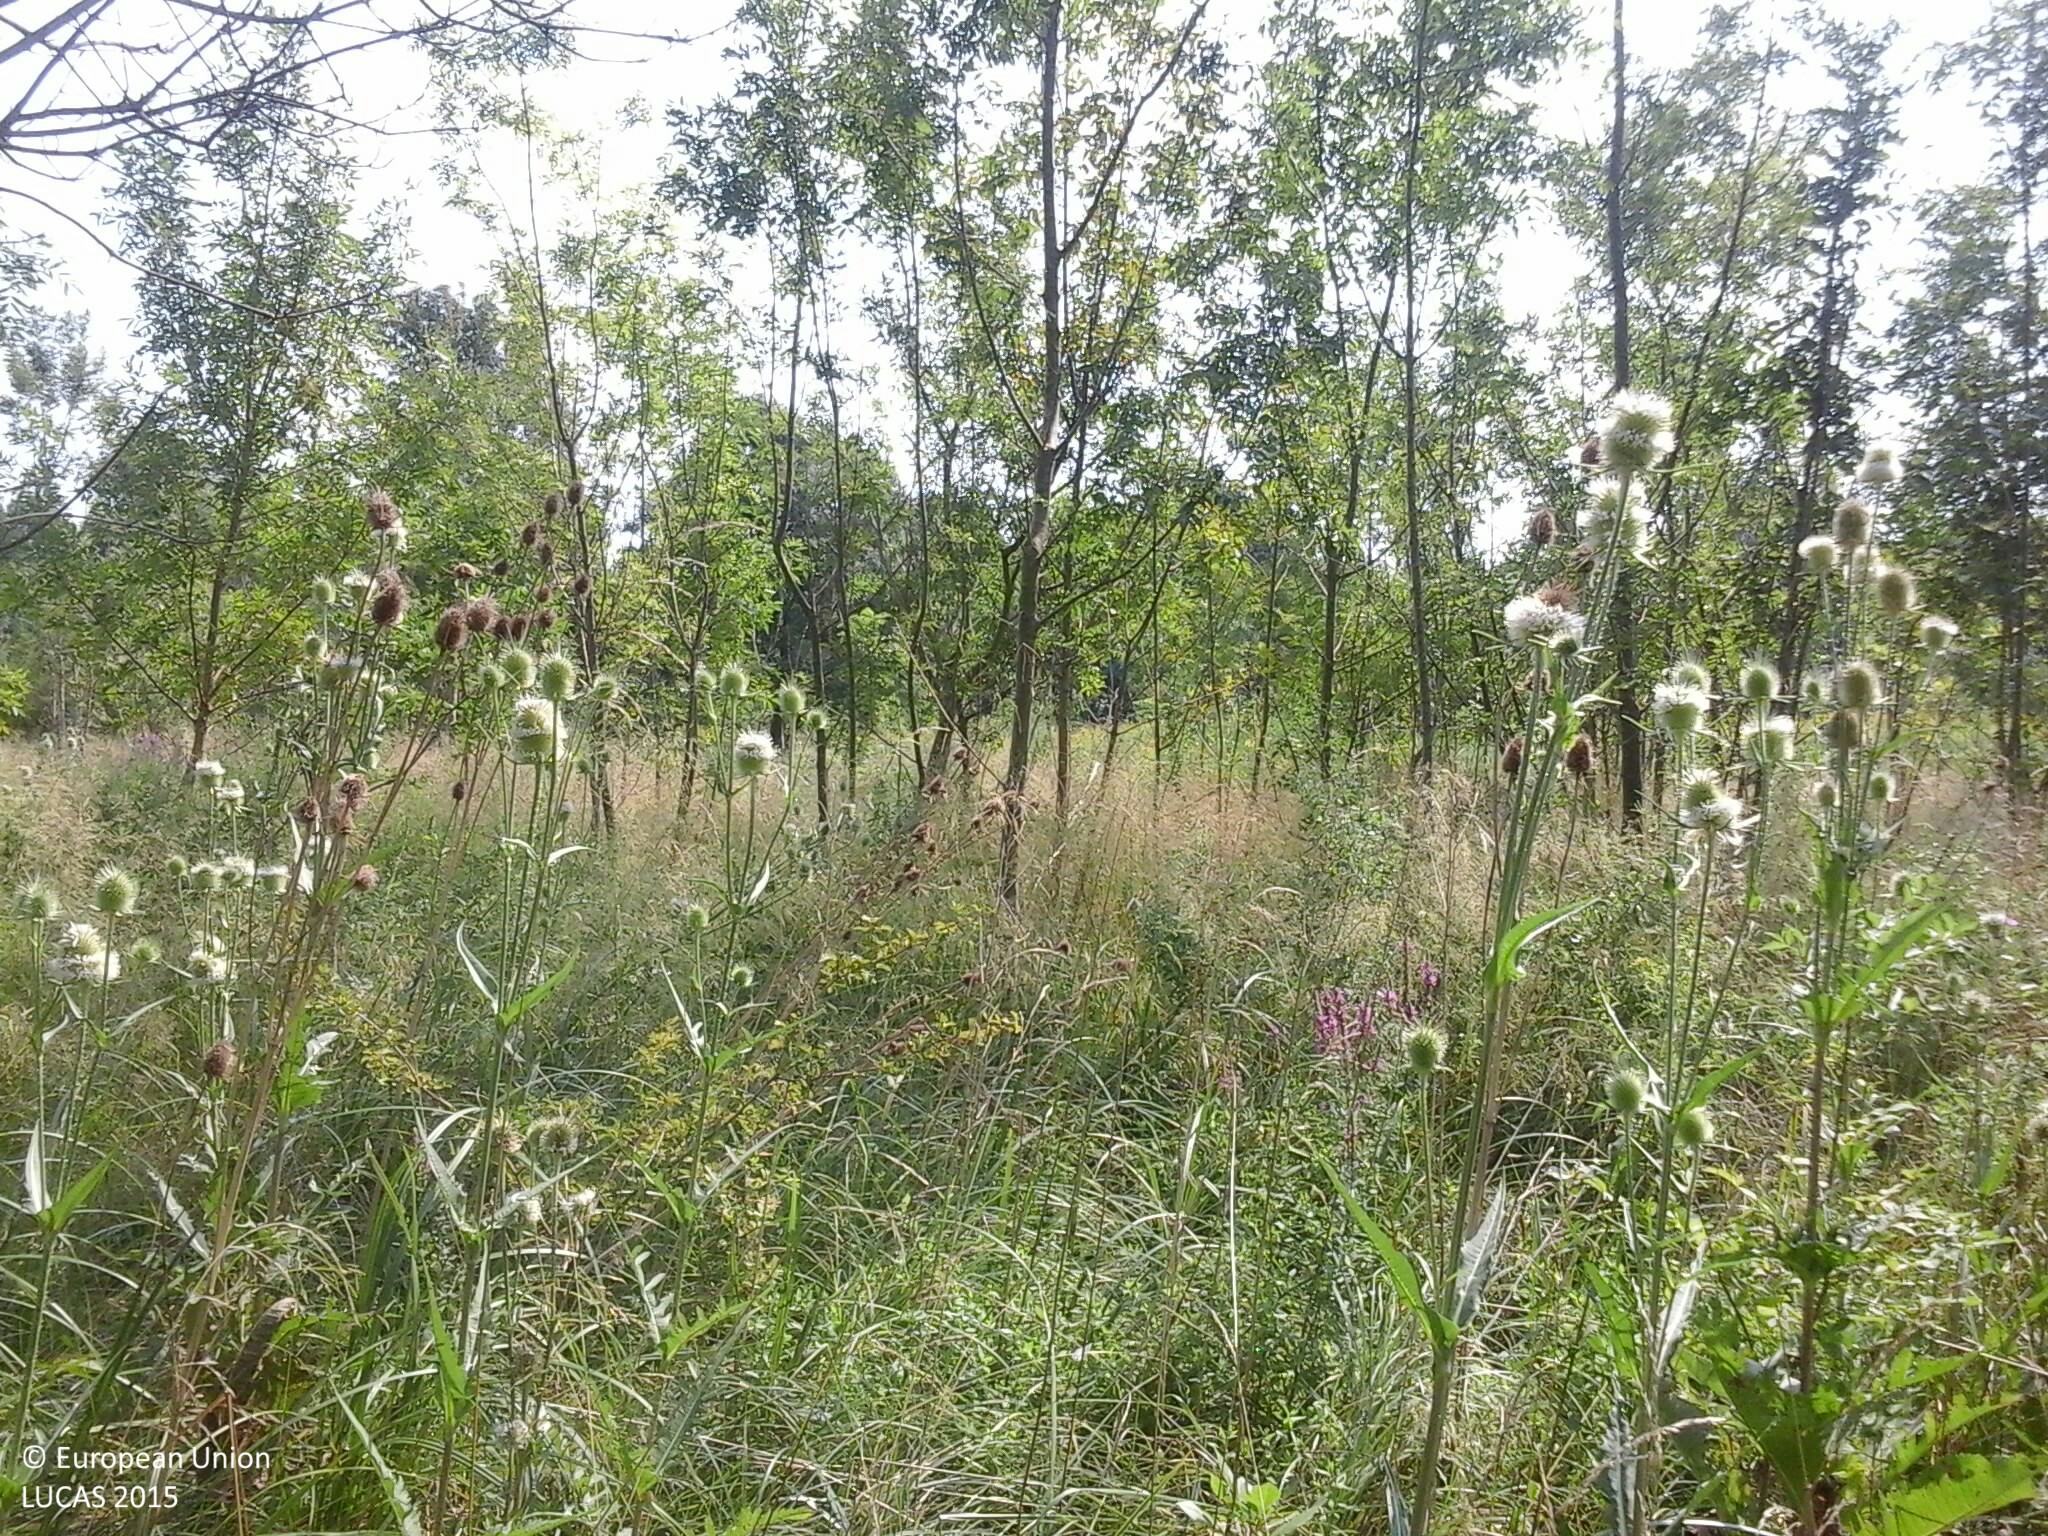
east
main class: Woodland
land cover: Broadleaved woodland
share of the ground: 25 - 50 %
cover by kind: herbaceous plants 60 %, broadleaved forest trees 40 %
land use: Abandoned areas
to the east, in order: Broadleaved woodland; Grassland with sparse tree/shrub cover; Broadleaved woodland; Ditches and canals; Broadleaved woodland; Tracks; Grassland without tree/shrub cover; Broadleaved woodland
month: August
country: HU
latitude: 46.0391
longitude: 18.1601
